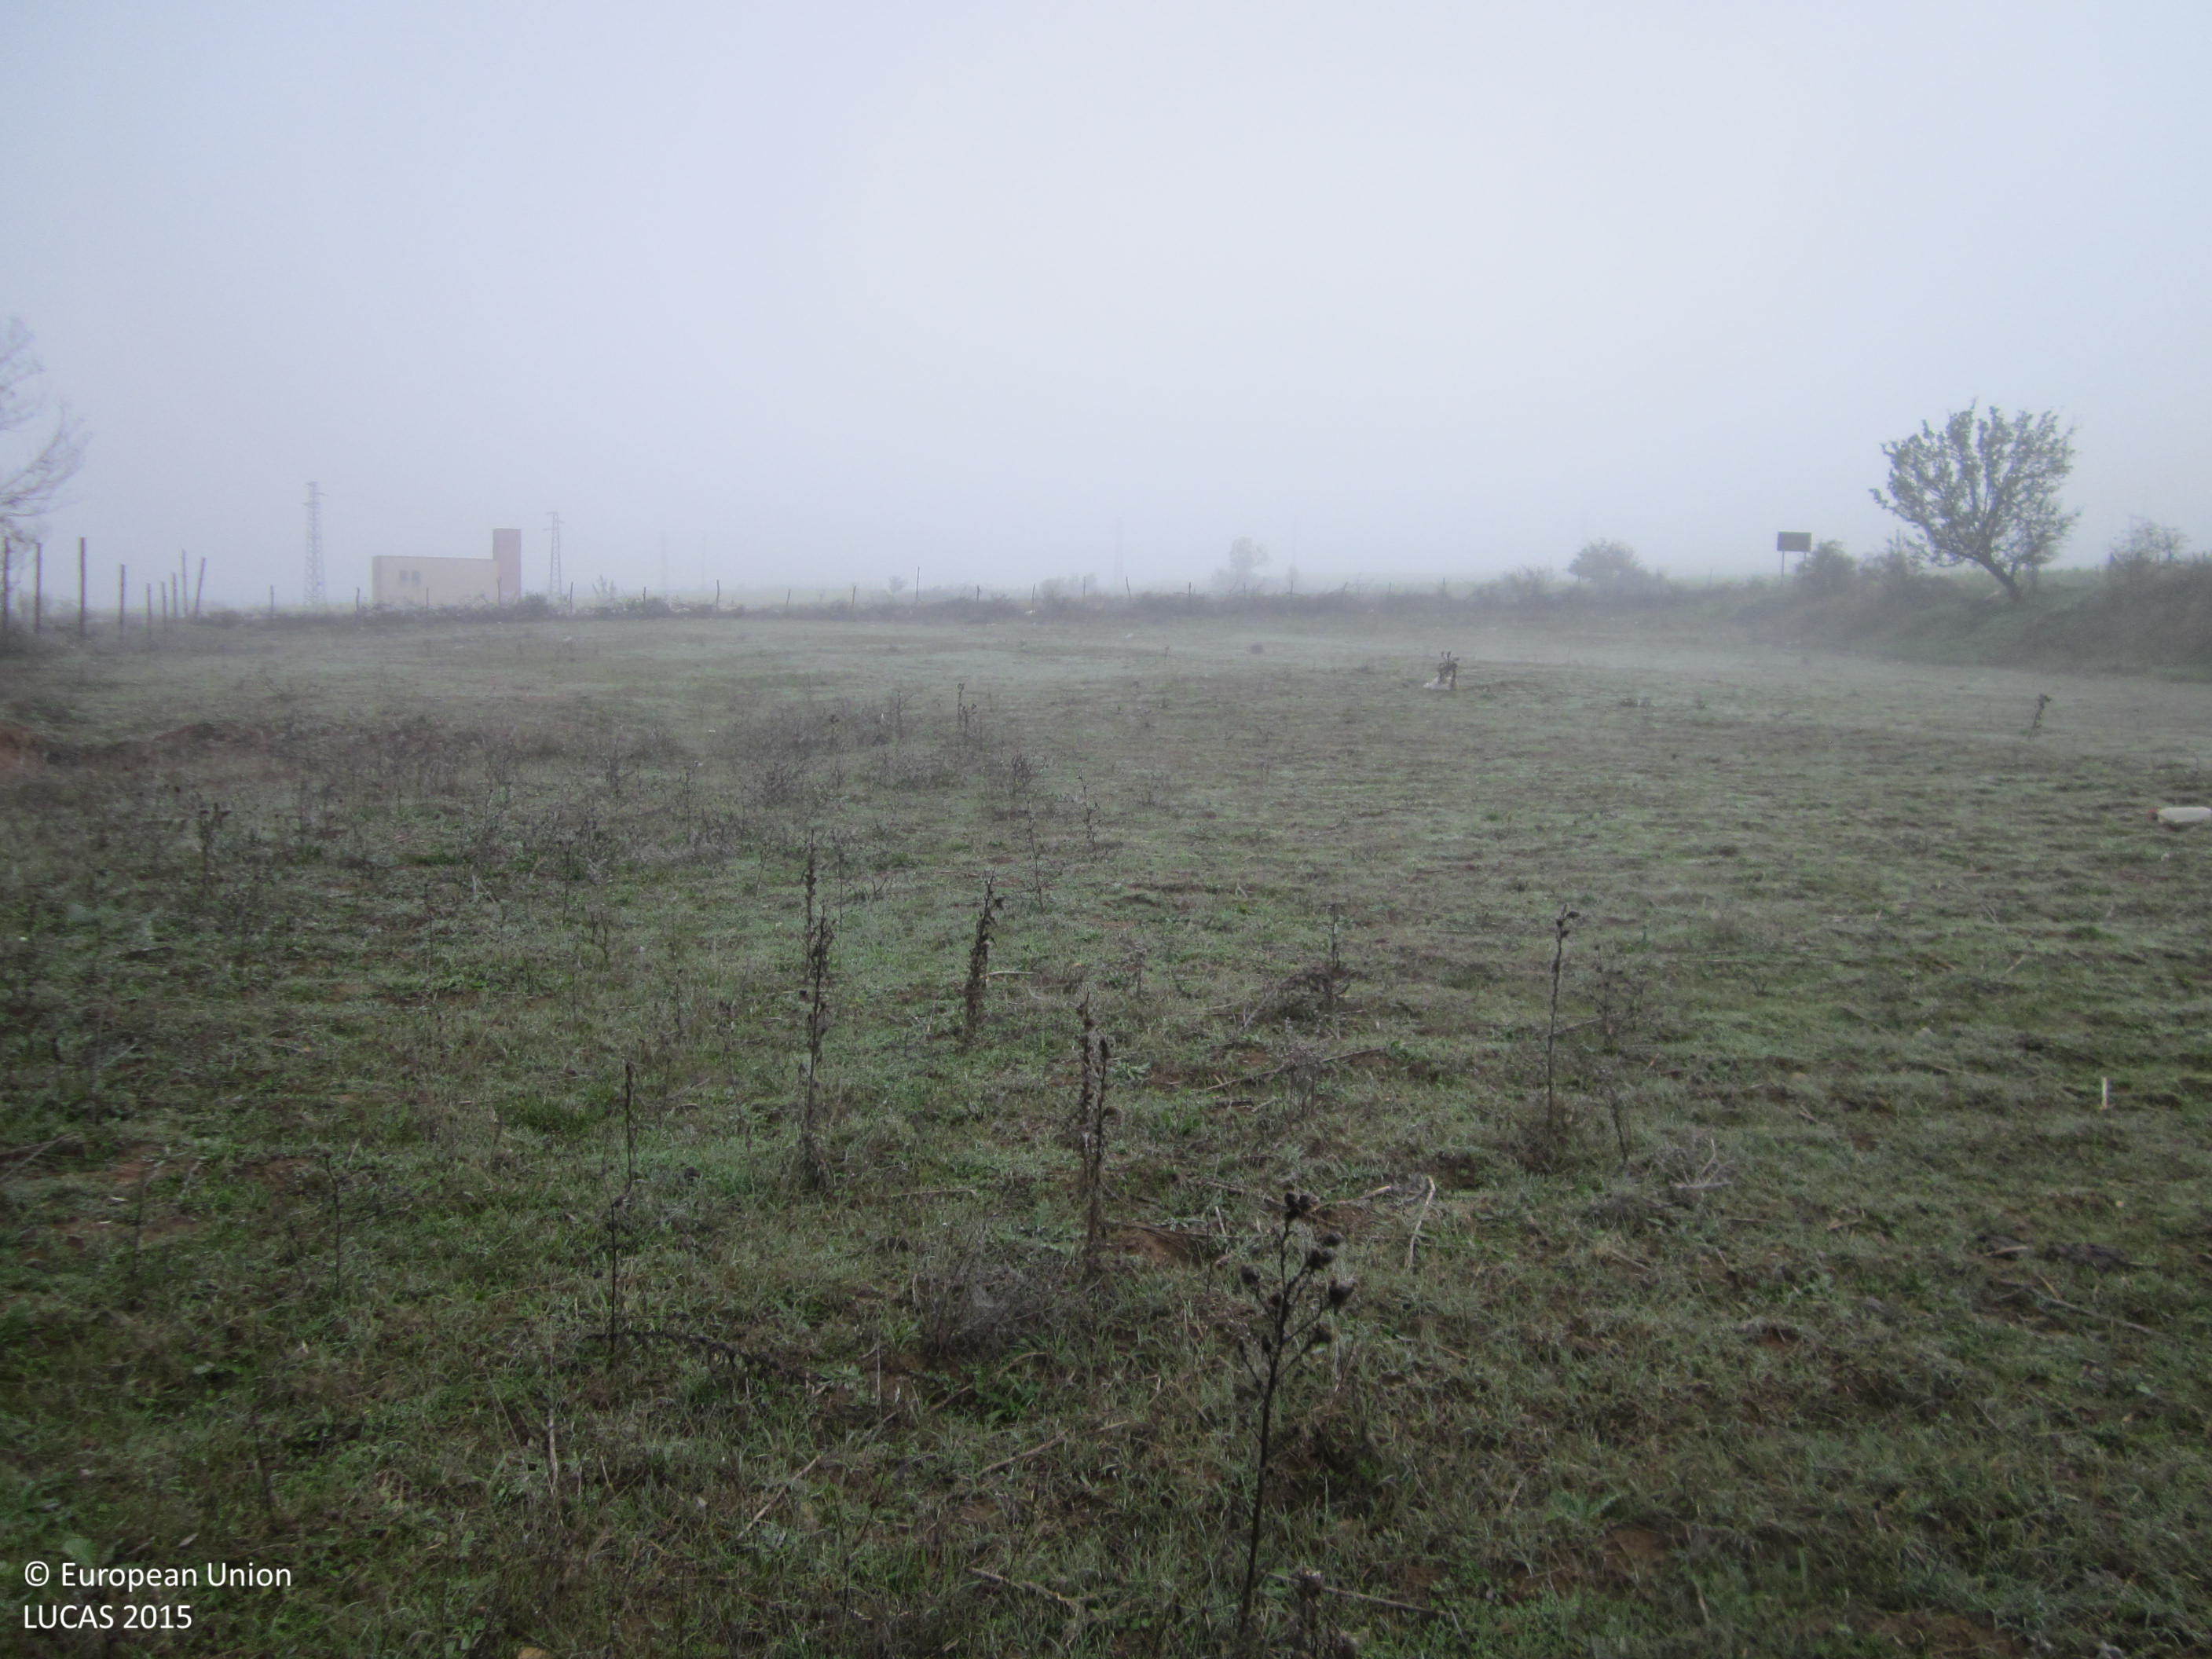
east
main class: Grassland
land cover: Grassland without tree/shrub cover
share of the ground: > 75 %
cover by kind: herbaceous plants 100 %
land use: Agriculture (excluding fallow land and kitchen gardens)
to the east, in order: Grassland without tree/shrub cover; Fences; Grassland without tree/shrub cover; Artificial constructions in urban areas; Grassland without tree/shrub cover; Paved roads, cycling and walking lanes; Grass margins; Fences; Grassland without tree/shrub cover; Other fresh vegetables; Electric lines; Other fresh vegetables
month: October
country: BG
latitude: 41.4675
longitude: 25.6373
